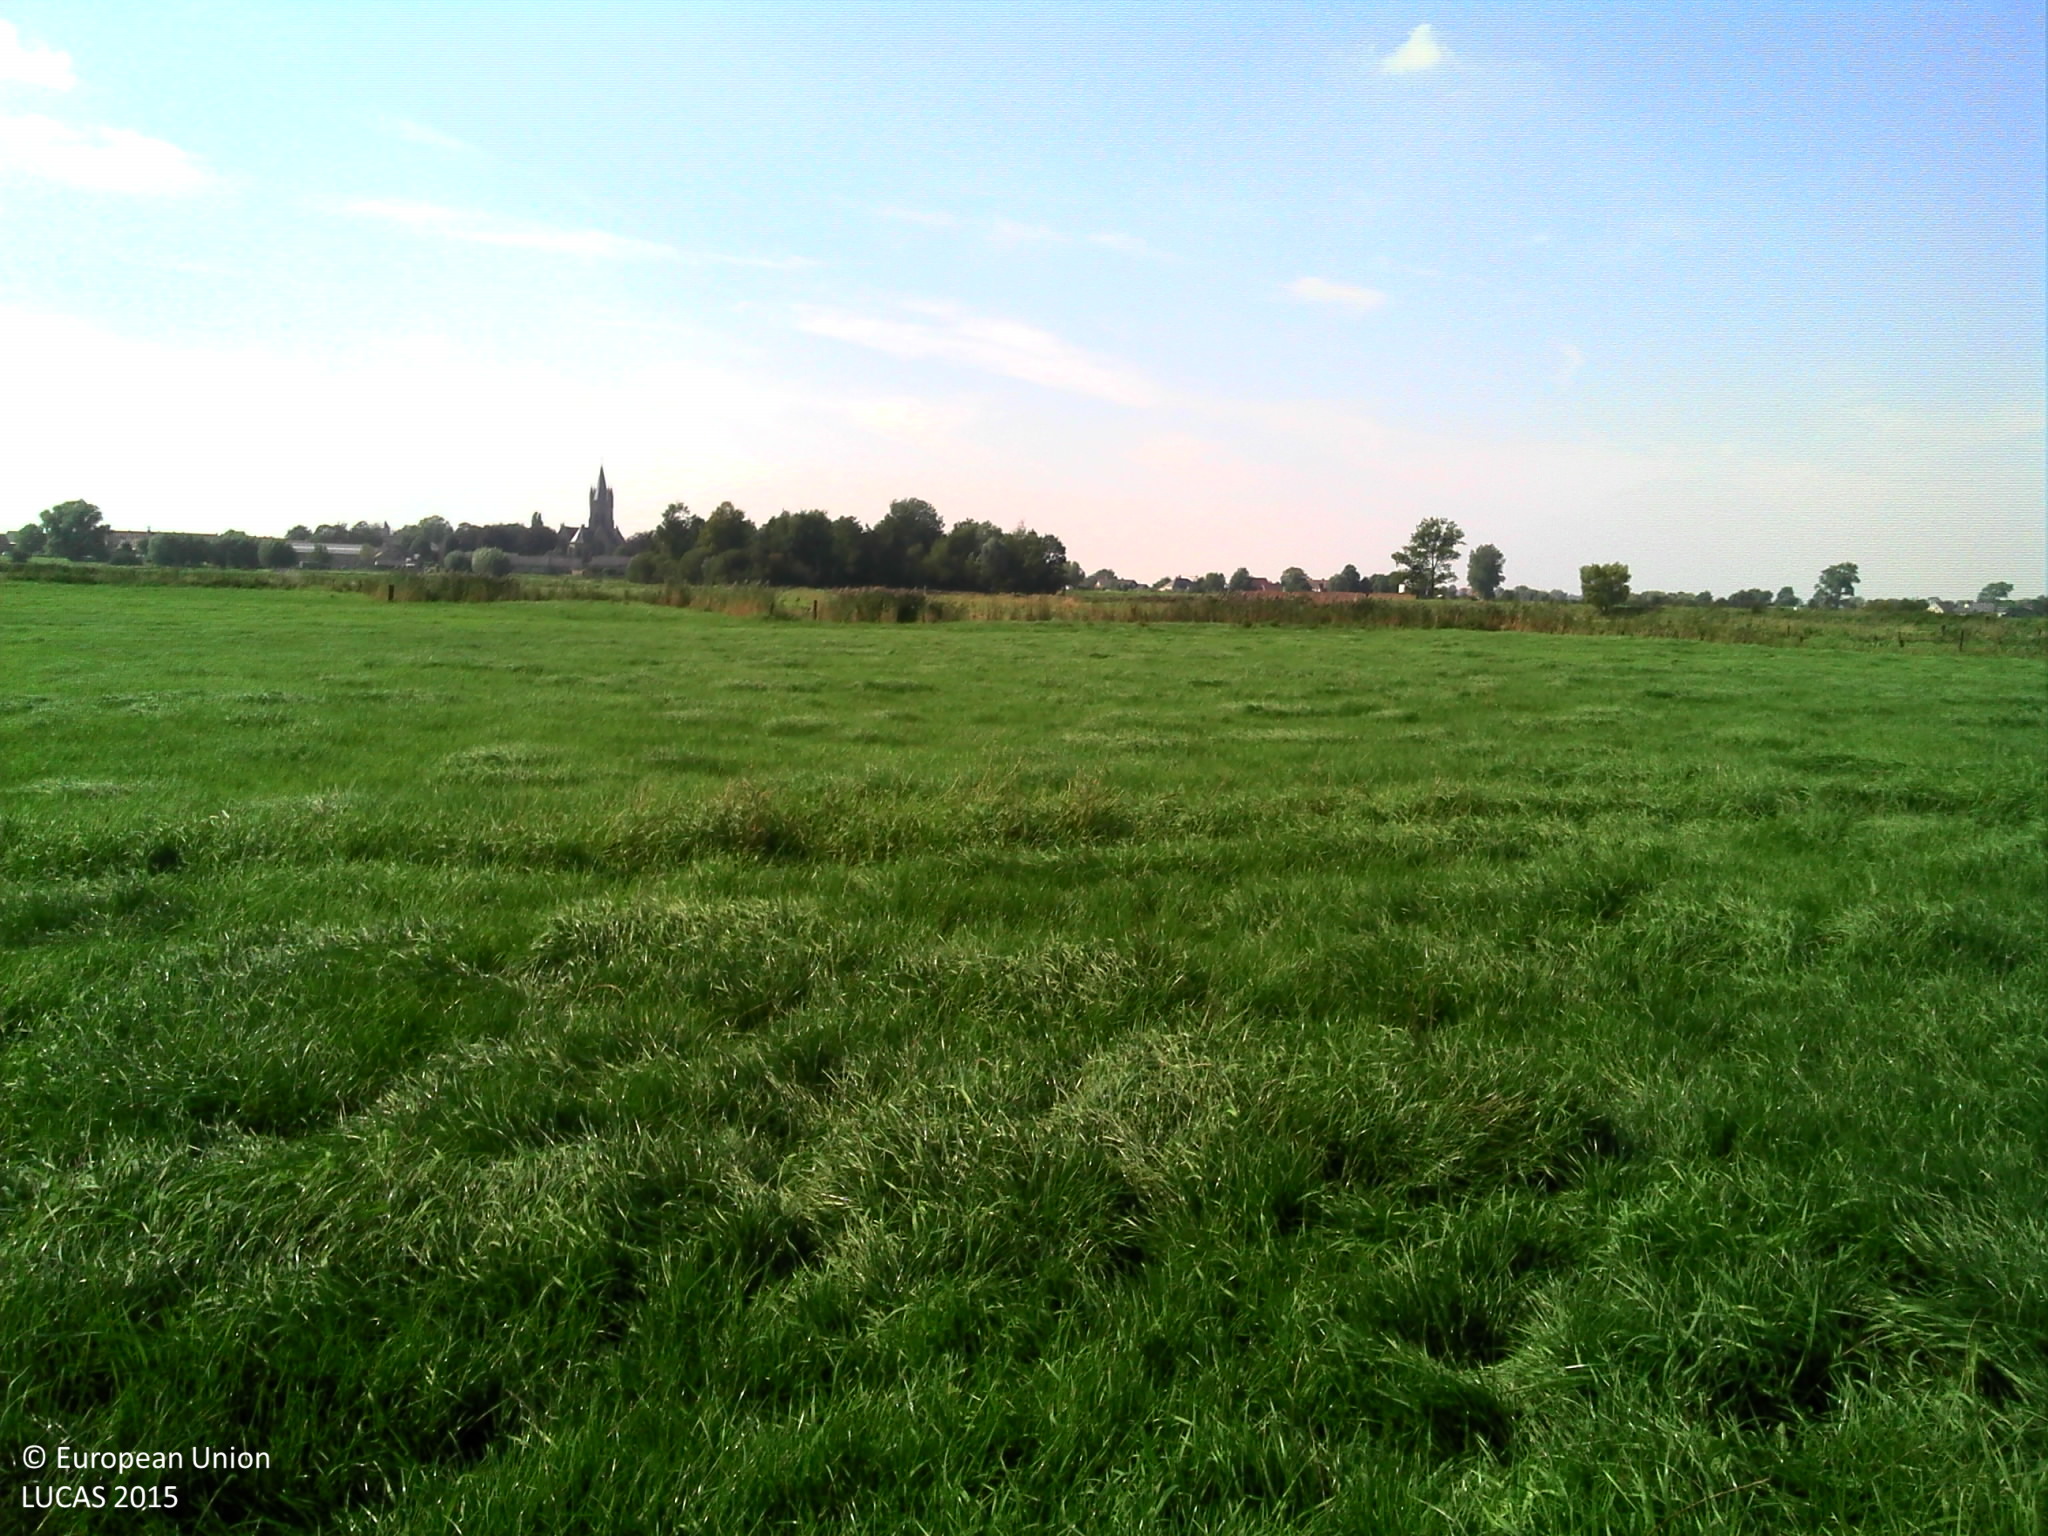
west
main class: Grassland
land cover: Grassland without tree/shrub cover
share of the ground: > 75 %
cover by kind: herbaceous plants 100 %
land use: Agriculture (excluding fallow land and kitchen gardens)
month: September
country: BE
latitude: 50.9494
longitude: 2.8006
